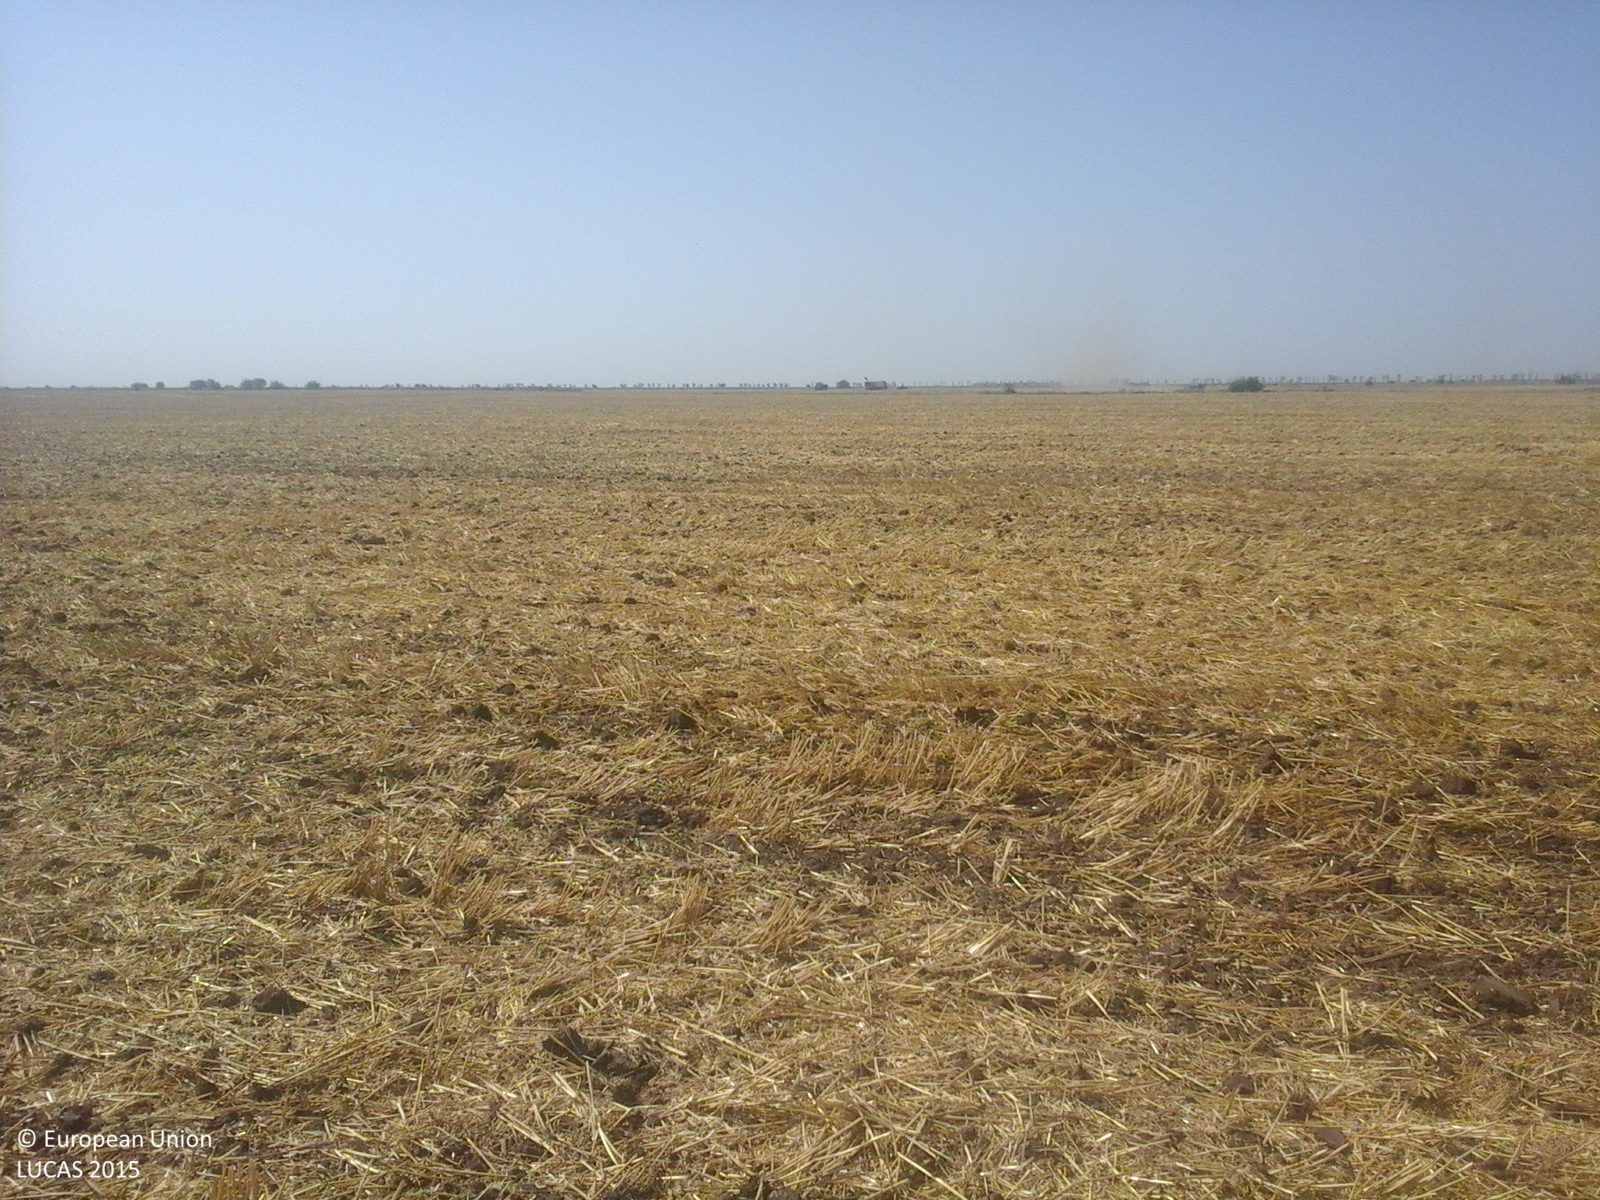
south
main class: Cropland
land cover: Common wheat
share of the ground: 10 - 25 %
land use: Agriculture (excluding fallow land and kitchen gardens)
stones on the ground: < 10 %
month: July
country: RO
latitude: 44.3665
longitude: 27.1341
